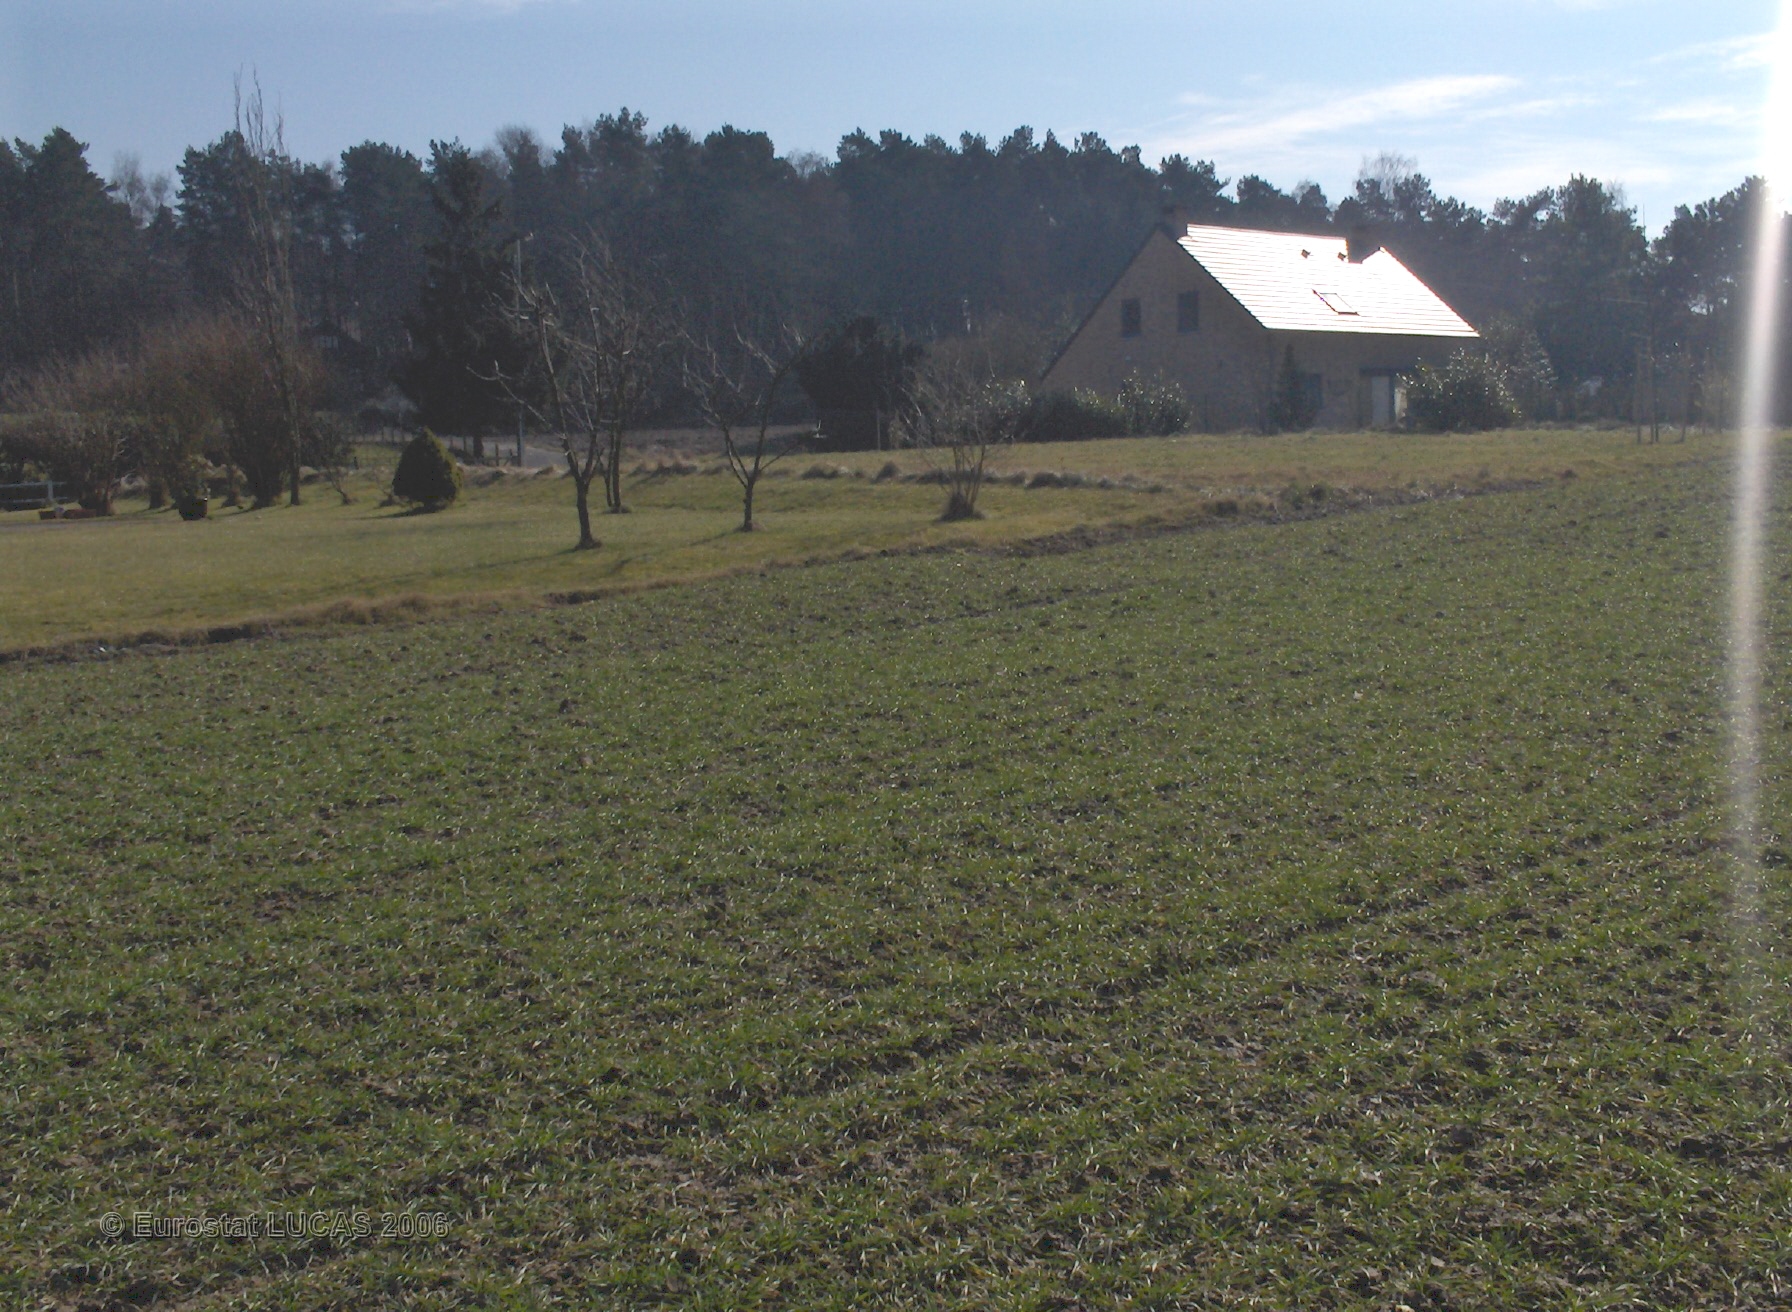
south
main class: Cropland
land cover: Common wheat
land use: Agriculture (excluding fallow land and kitchen gardens)
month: March
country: BE
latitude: 50.6129
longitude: 4.5551
